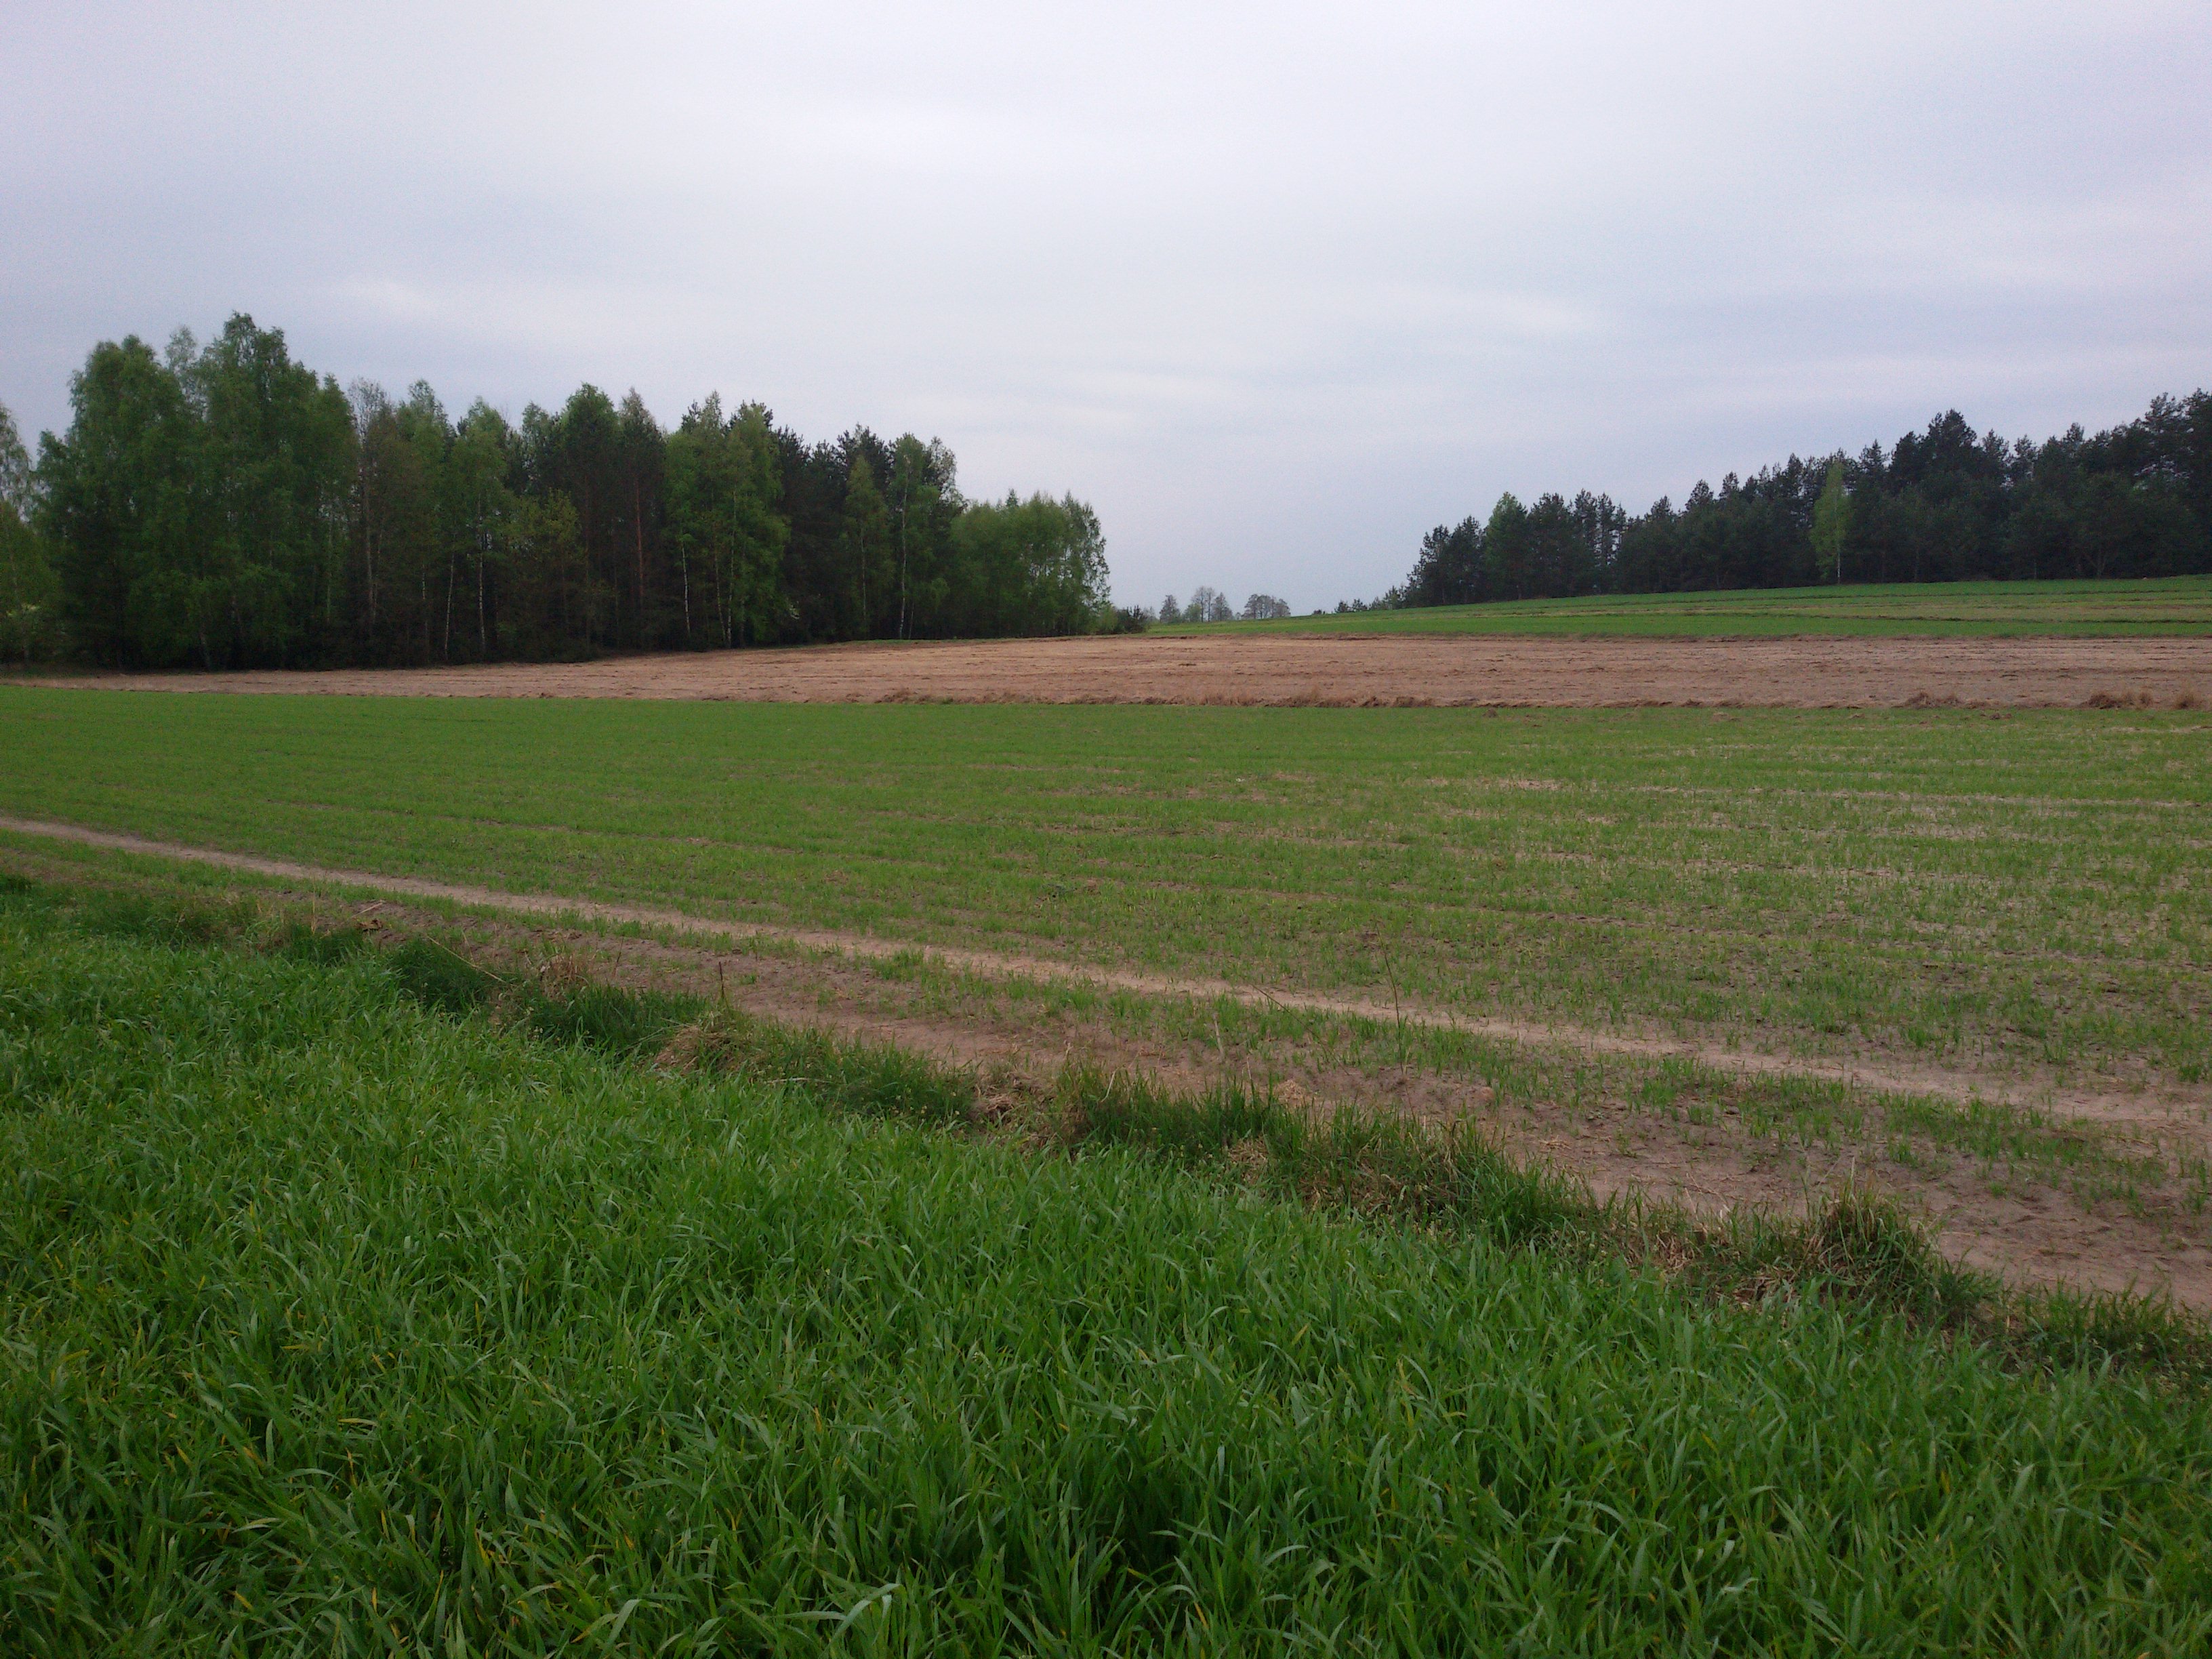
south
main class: Cropland
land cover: Barley
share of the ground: > 75 %
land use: Agriculture (excluding fallow land and kitchen gardens)
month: May
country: PL
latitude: 52.8558
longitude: 22.0134
